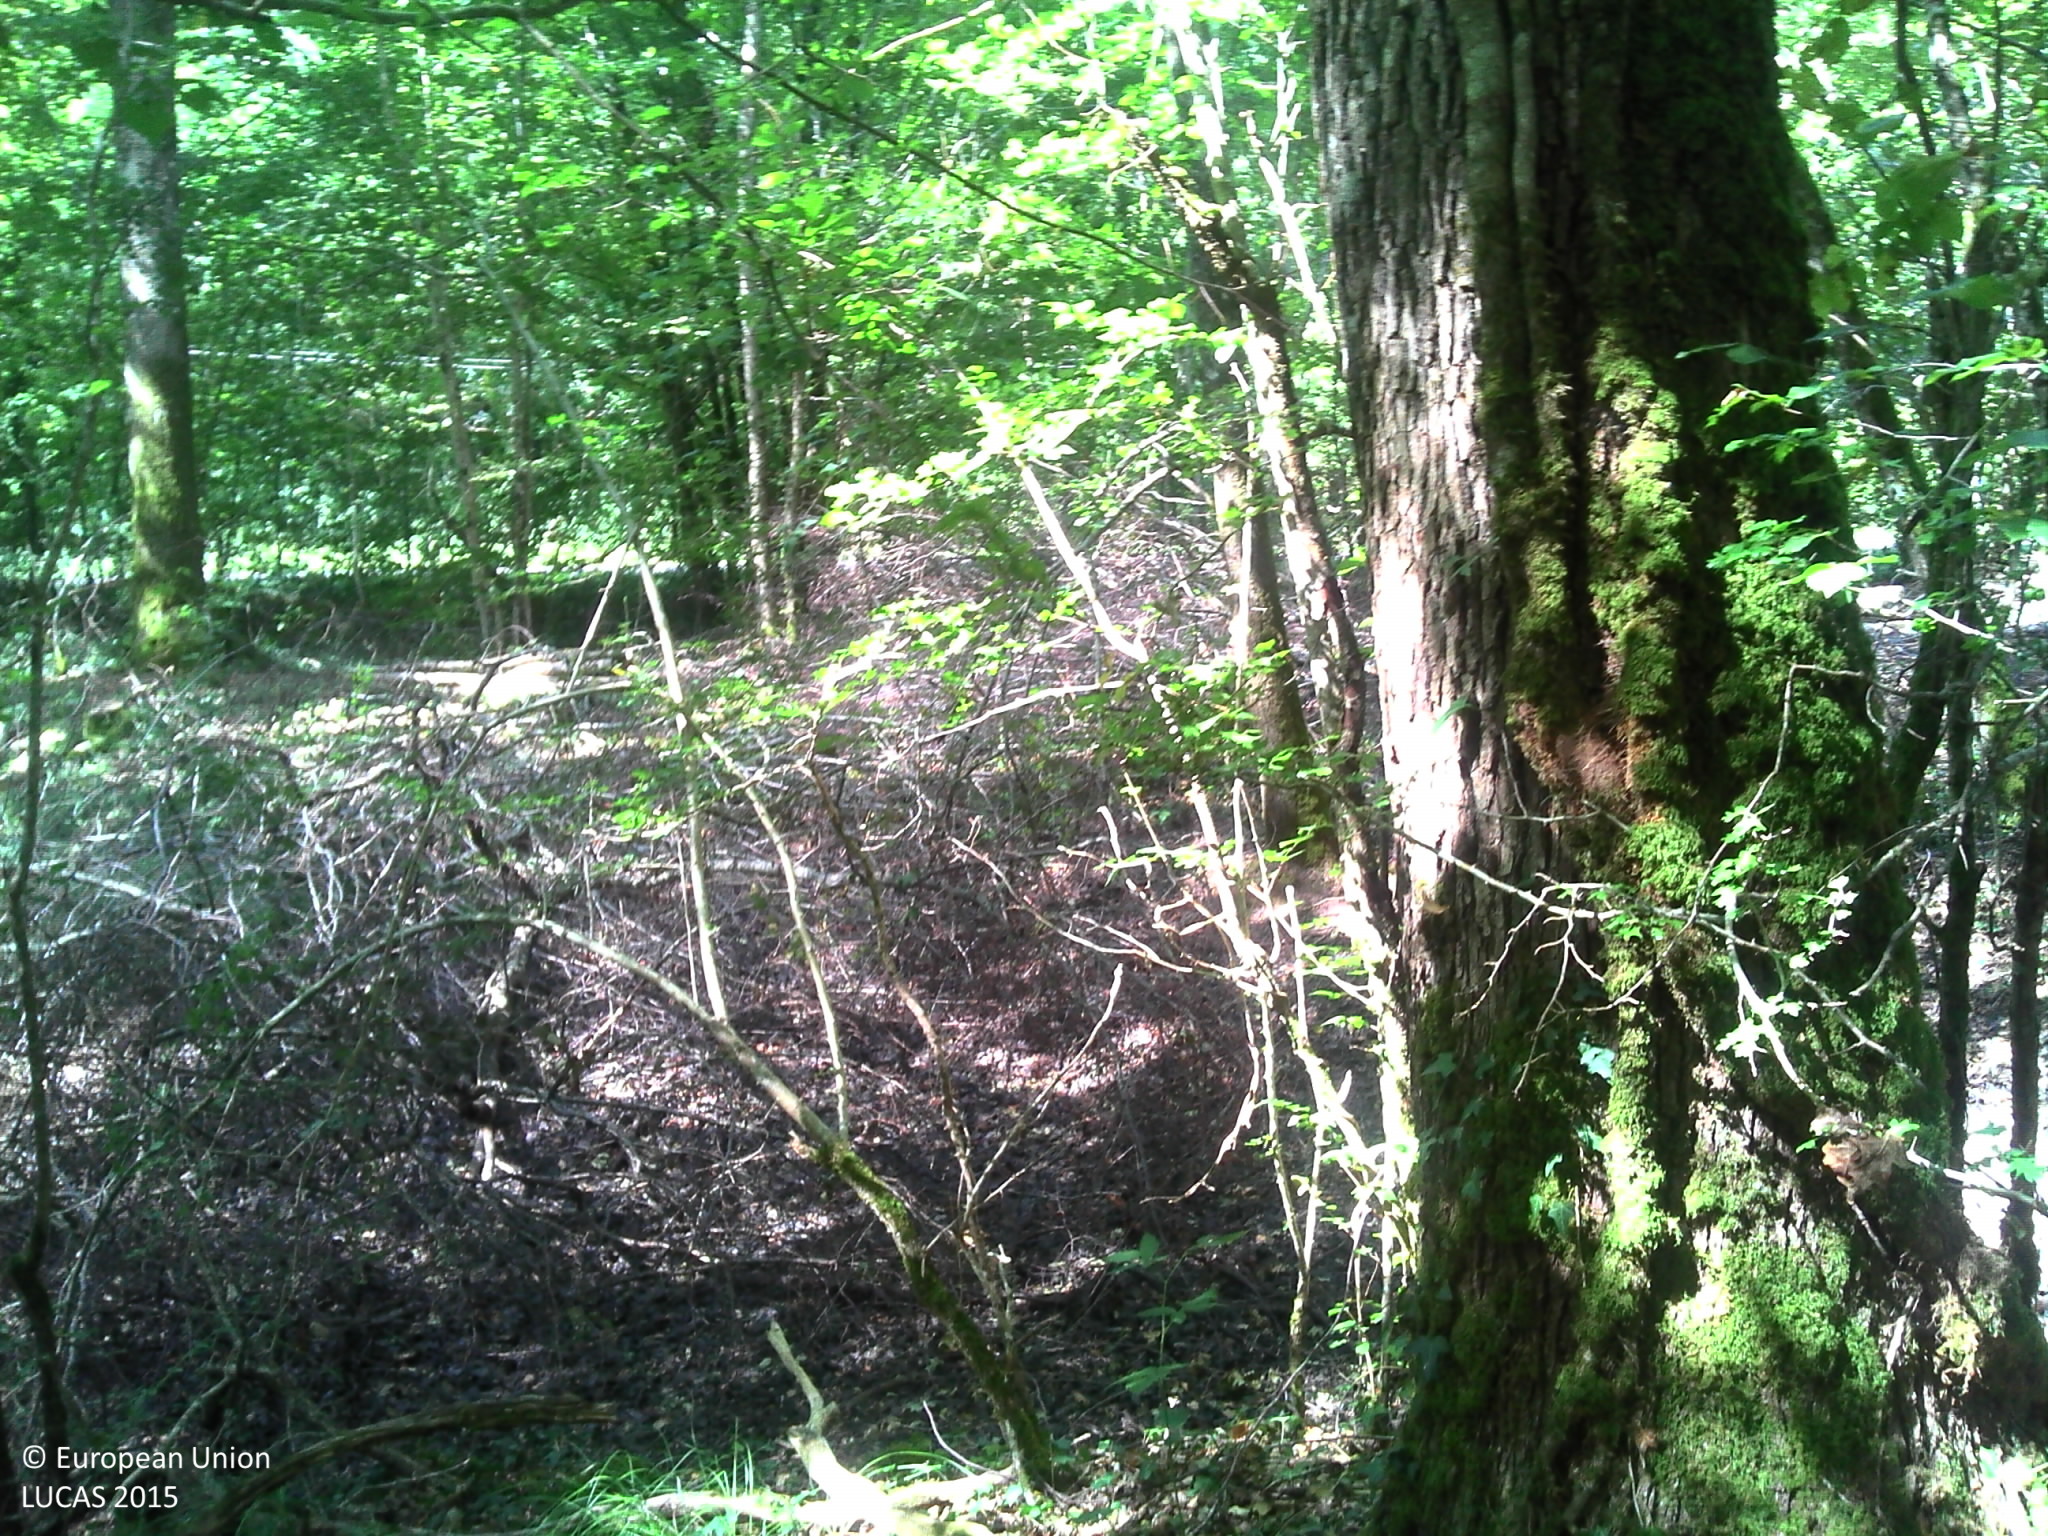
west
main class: Woodland
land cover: Broadleaved woodland
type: mesophytic deciduous forest
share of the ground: > 75 %
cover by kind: broadleaved forest trees 90 %, herbaceous plants 10 %
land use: Forestry
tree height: > 5 m
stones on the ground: < 10 %
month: September
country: FR
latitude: 46.7898
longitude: 1.4867
